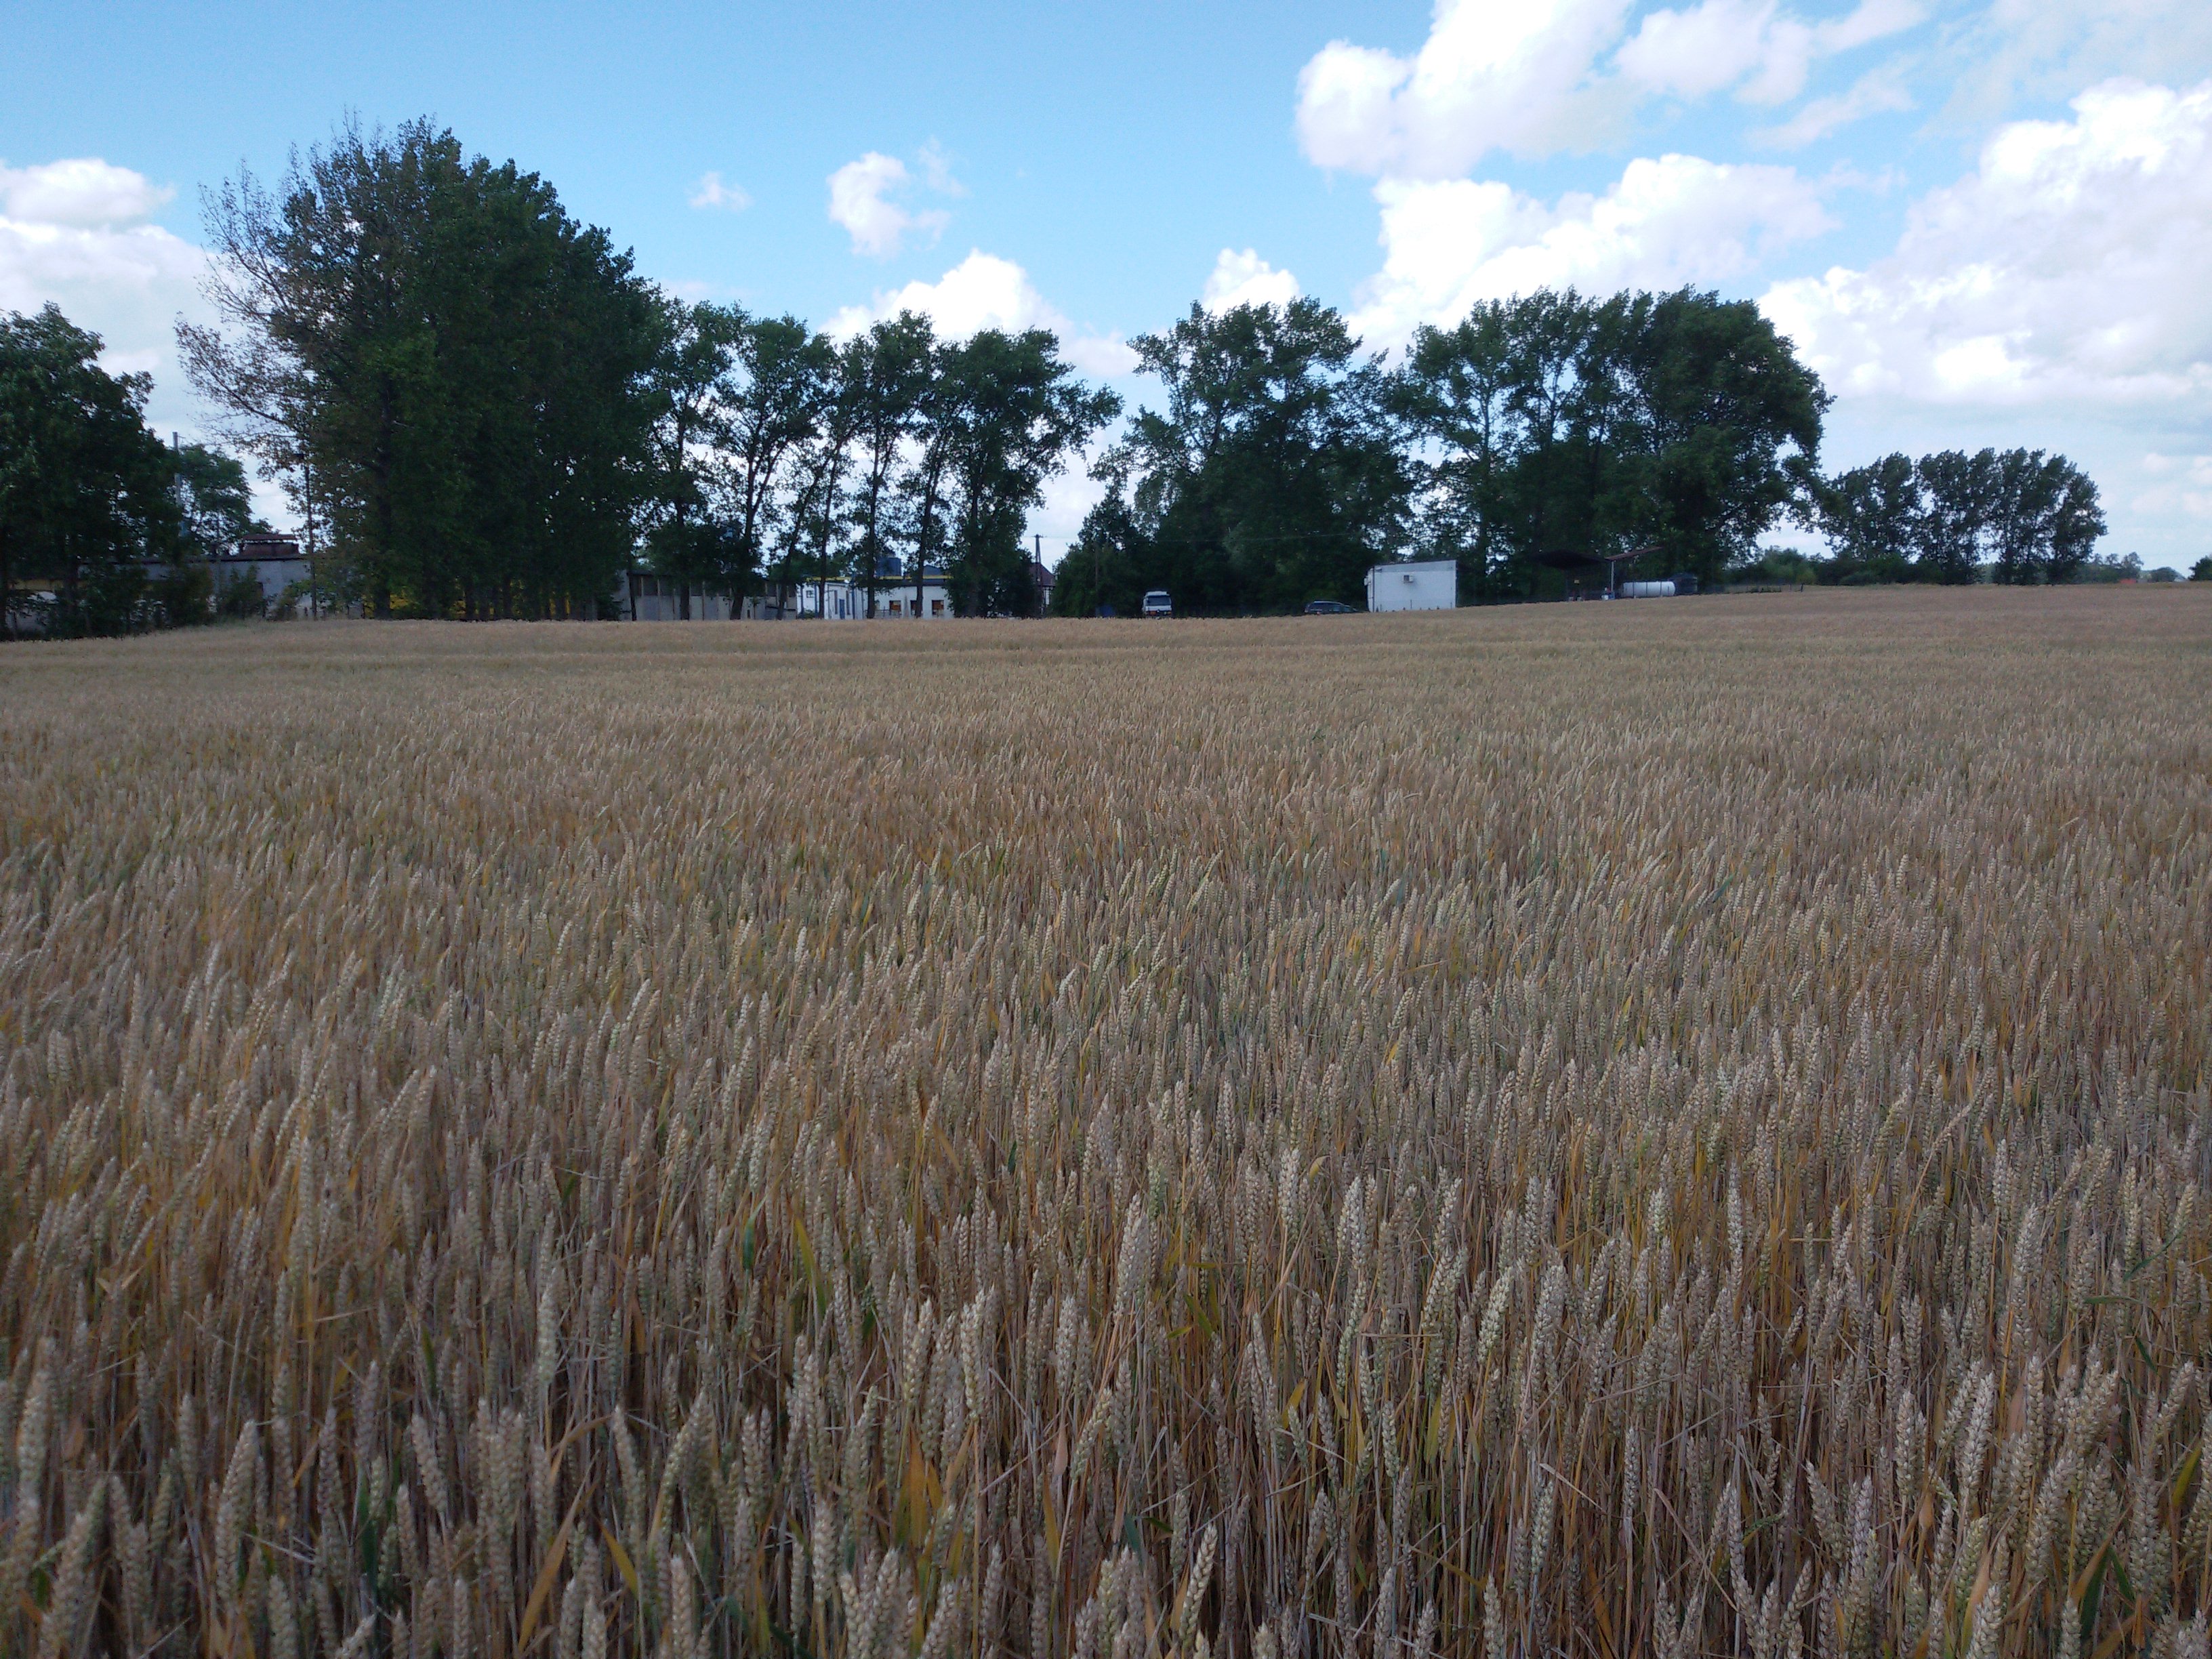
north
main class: Cropland
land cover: Common wheat
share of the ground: > 75 %
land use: Agriculture (excluding fallow land and kitchen gardens)
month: July
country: PL
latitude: 52.7863
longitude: 17.5598
